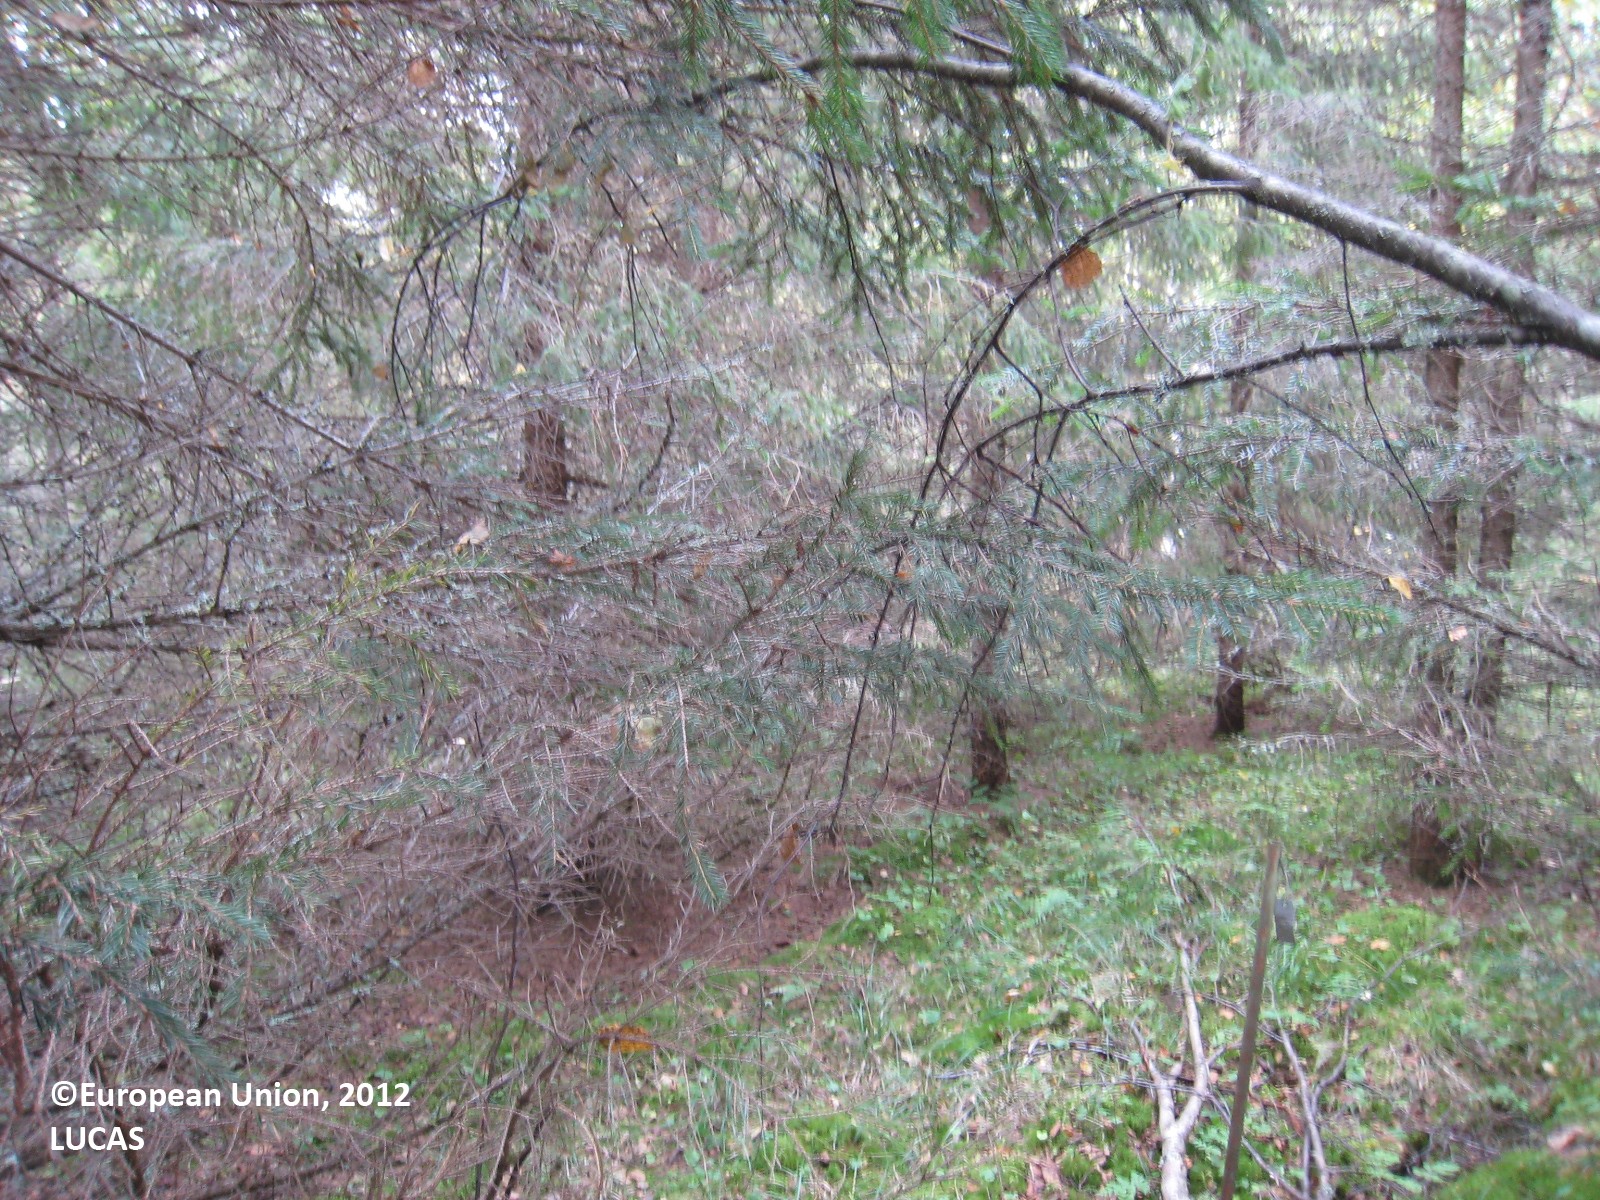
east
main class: Woodland
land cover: Spruce dominated mixed woodland
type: boreal forest
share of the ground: > 75 %
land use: Forestry
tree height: > 5 m
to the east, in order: Spruce dominated mixed woodland; Ditches and canals; Spruce dominated mixed woodland; Ditches and canals; Spruce dominated mixed woodland; Ditches and canals; Groves; Broadleaved woodland; Spruce dominated mixed woodland; Shruby margins; Tracks; Shruby margins; Ditches and canals; Broadleaved woodland; Spruce dominated mixed woodland; Broadleaved woodland
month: August
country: FI
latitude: 62.2936
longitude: 27.3824
